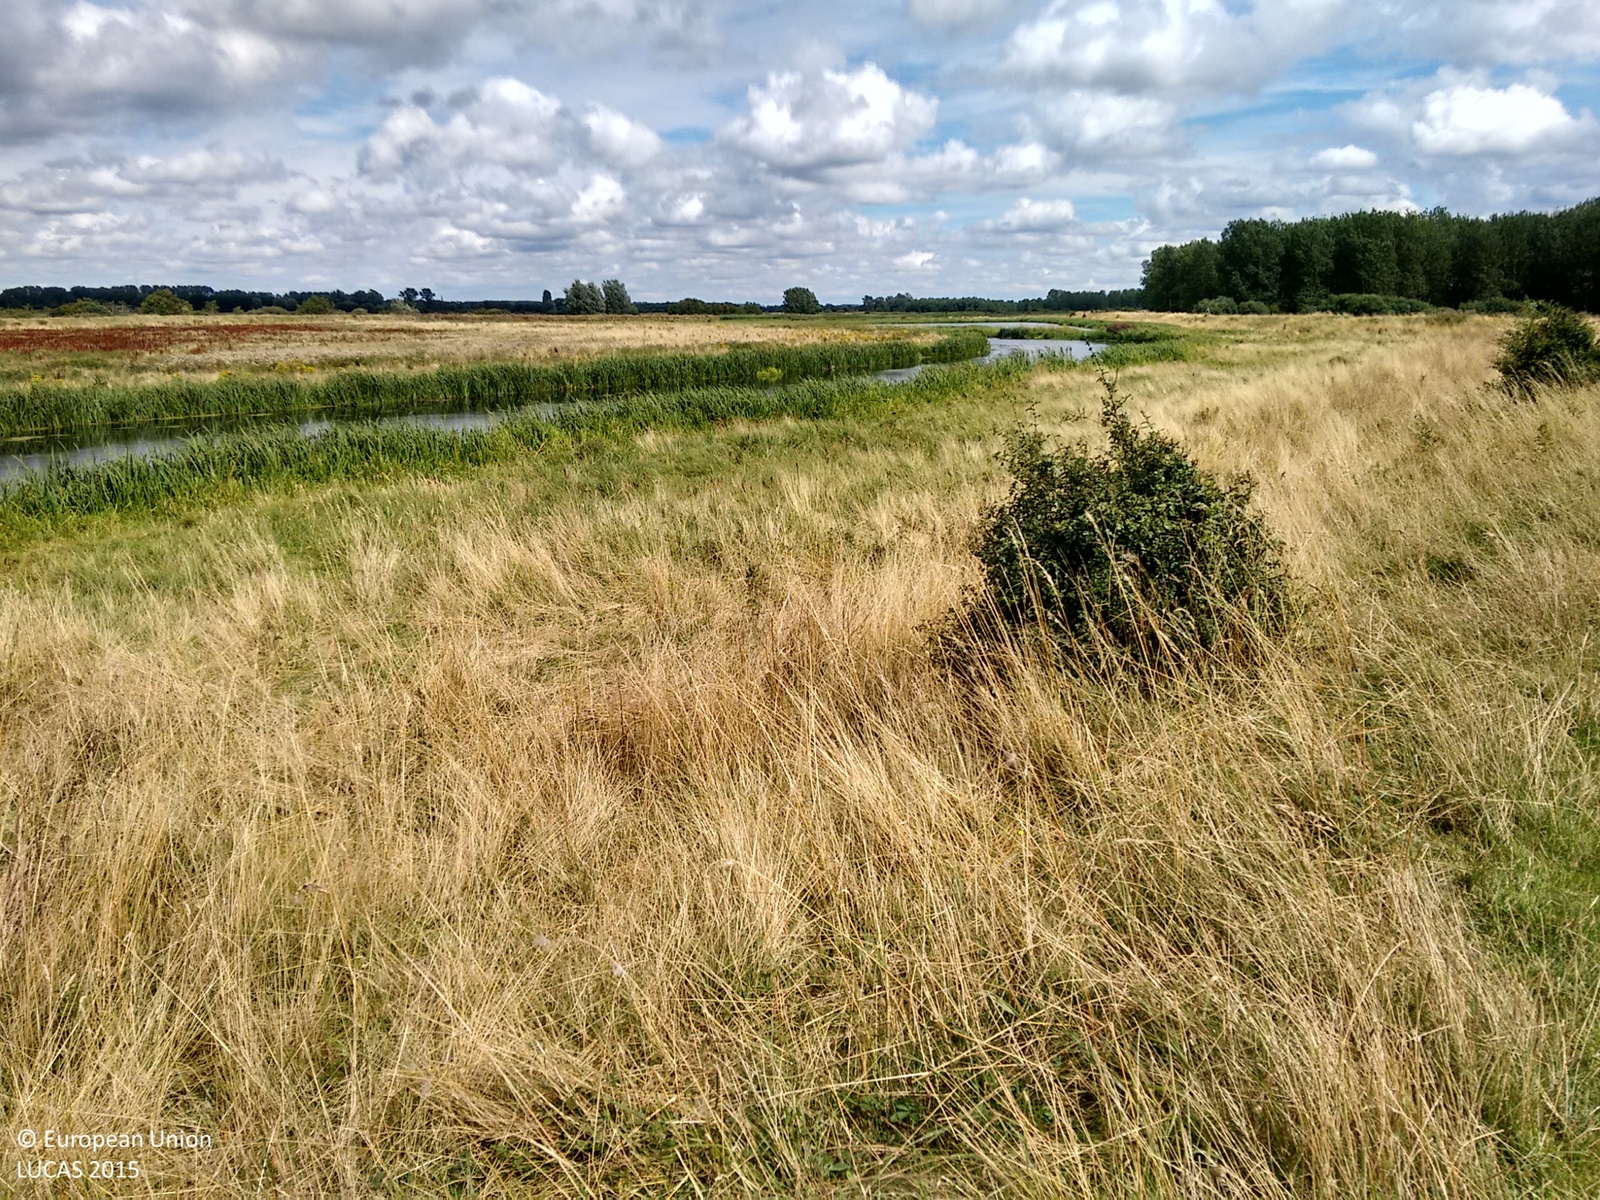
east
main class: Grassland
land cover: Grassland with sparse tree/shrub cover
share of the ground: > 75 %
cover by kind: herbaceous plants 95 %, broadleaved forest trees 5 %
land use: Agriculture (excluding fallow land and kitchen gardens)
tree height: < 5 m
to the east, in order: Grassland with sparse tree/shrub cover; Inland fresh running water; Inland marshes; Inland fresh running water
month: August
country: GB
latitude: 52.4493
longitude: 0.5116
